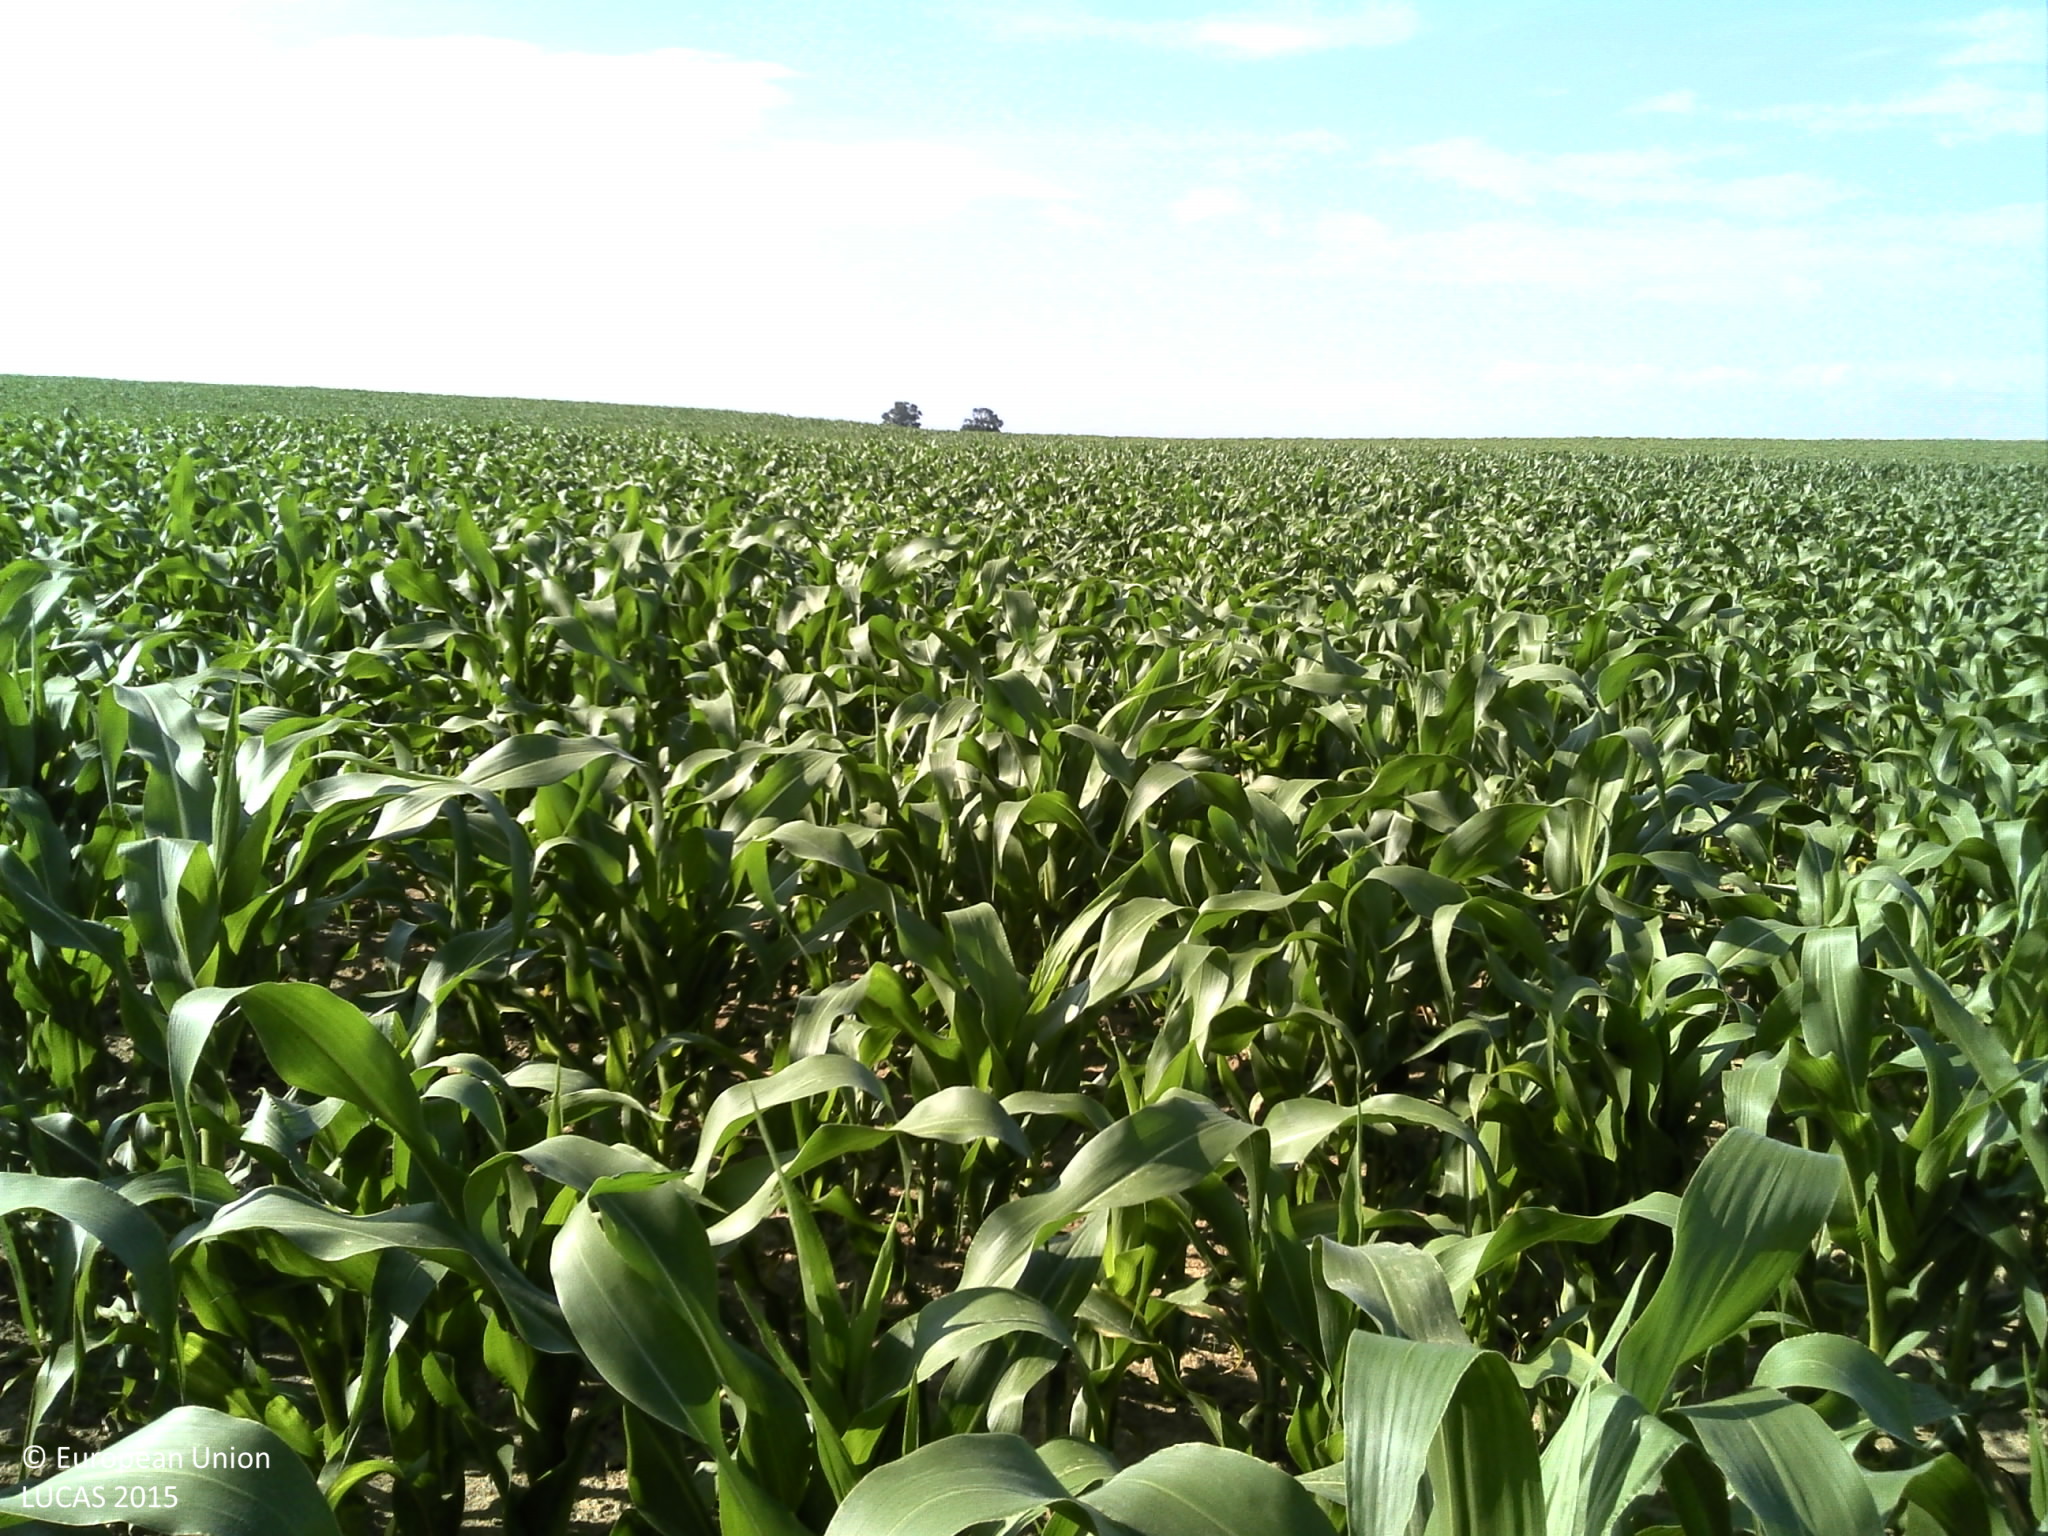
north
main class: Cropland
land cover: Maize
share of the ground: > 75 %
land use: Agriculture (excluding fallow land and kitchen gardens)
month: June
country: HR
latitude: 45.7364
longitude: 18.5539
